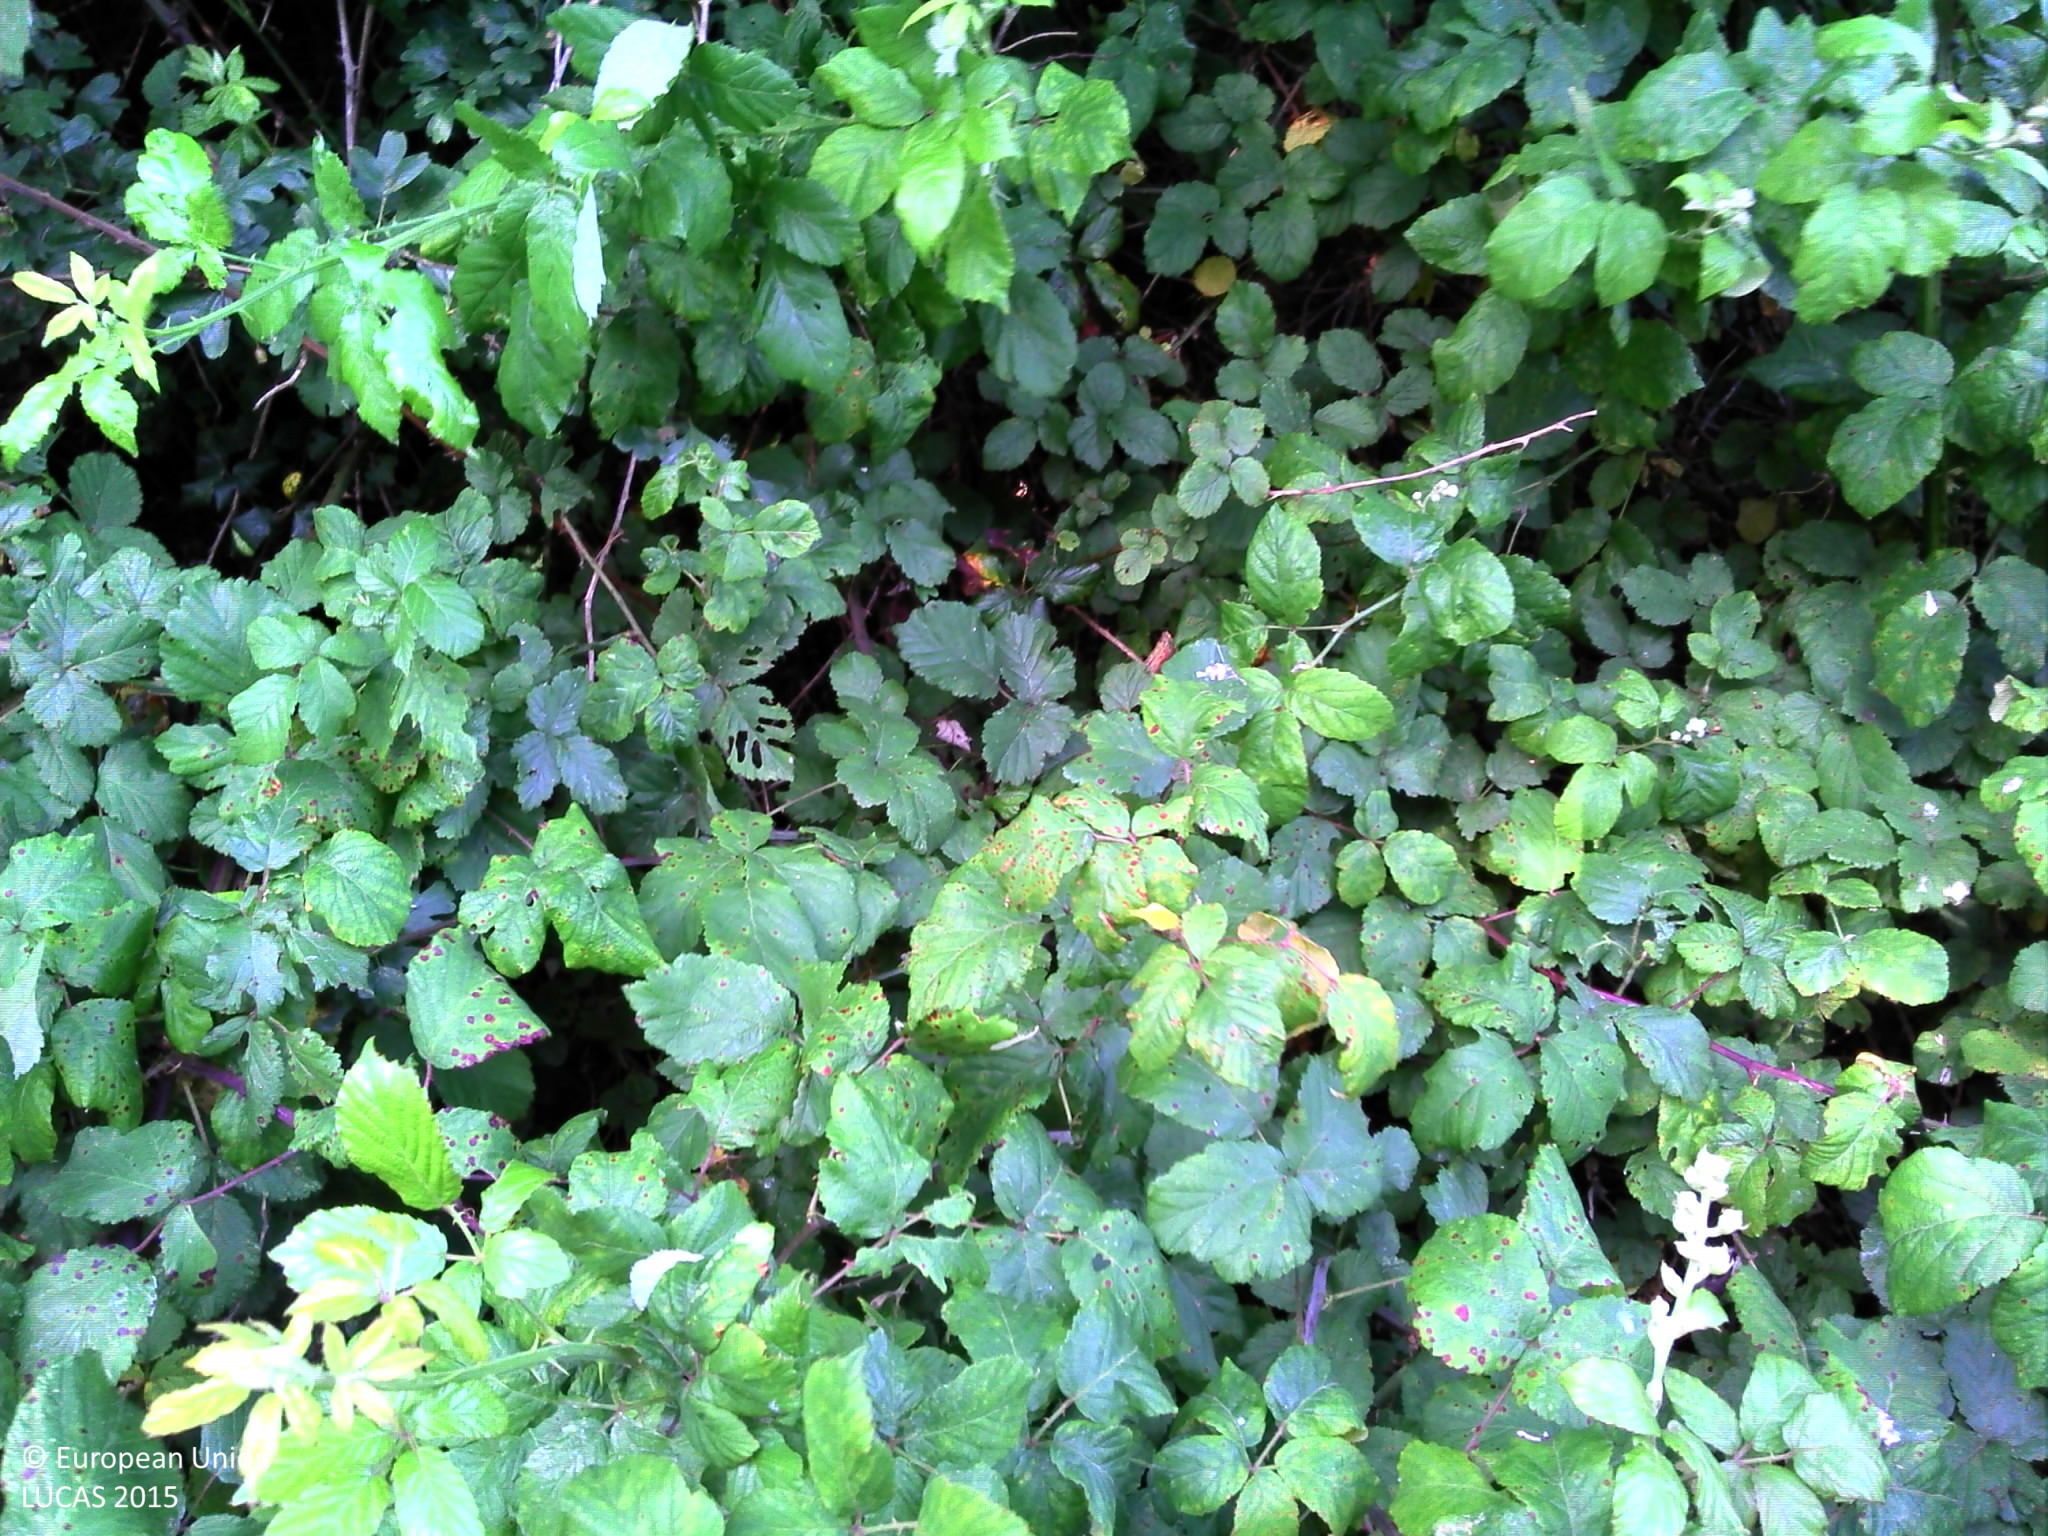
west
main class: Grassland
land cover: Spontaneously vegetated surfaces
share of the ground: > 75 %
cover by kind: herbaceous plants 95 %, shrubs 5 %
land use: Abandoned areas
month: June
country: FR
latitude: 47.1618
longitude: -1.5309
